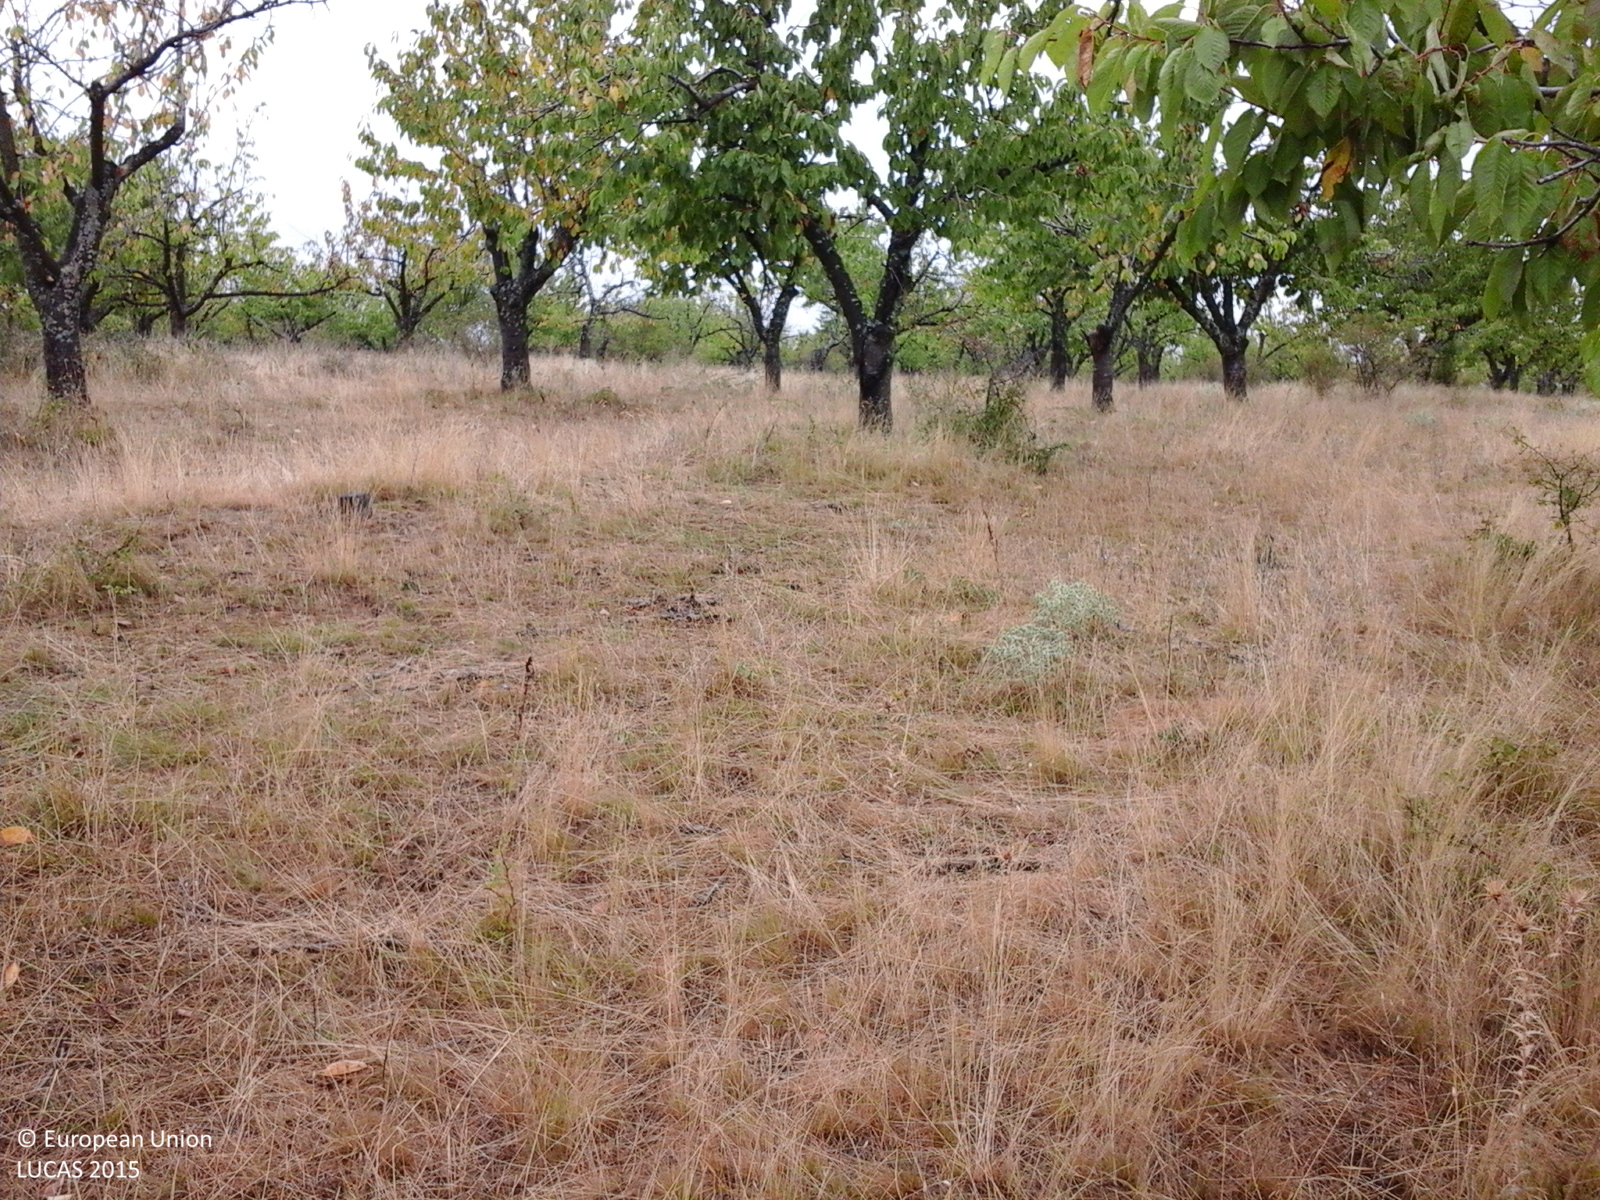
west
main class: Cropland
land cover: Cherry fruit
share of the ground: 50 - 75 %
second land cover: Grassland without tree/shrub cover
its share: > 75 %
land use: Agriculture (excluding fallow land and kitchen gardens)
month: August
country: RO
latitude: 45.9016
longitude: 21.4151
